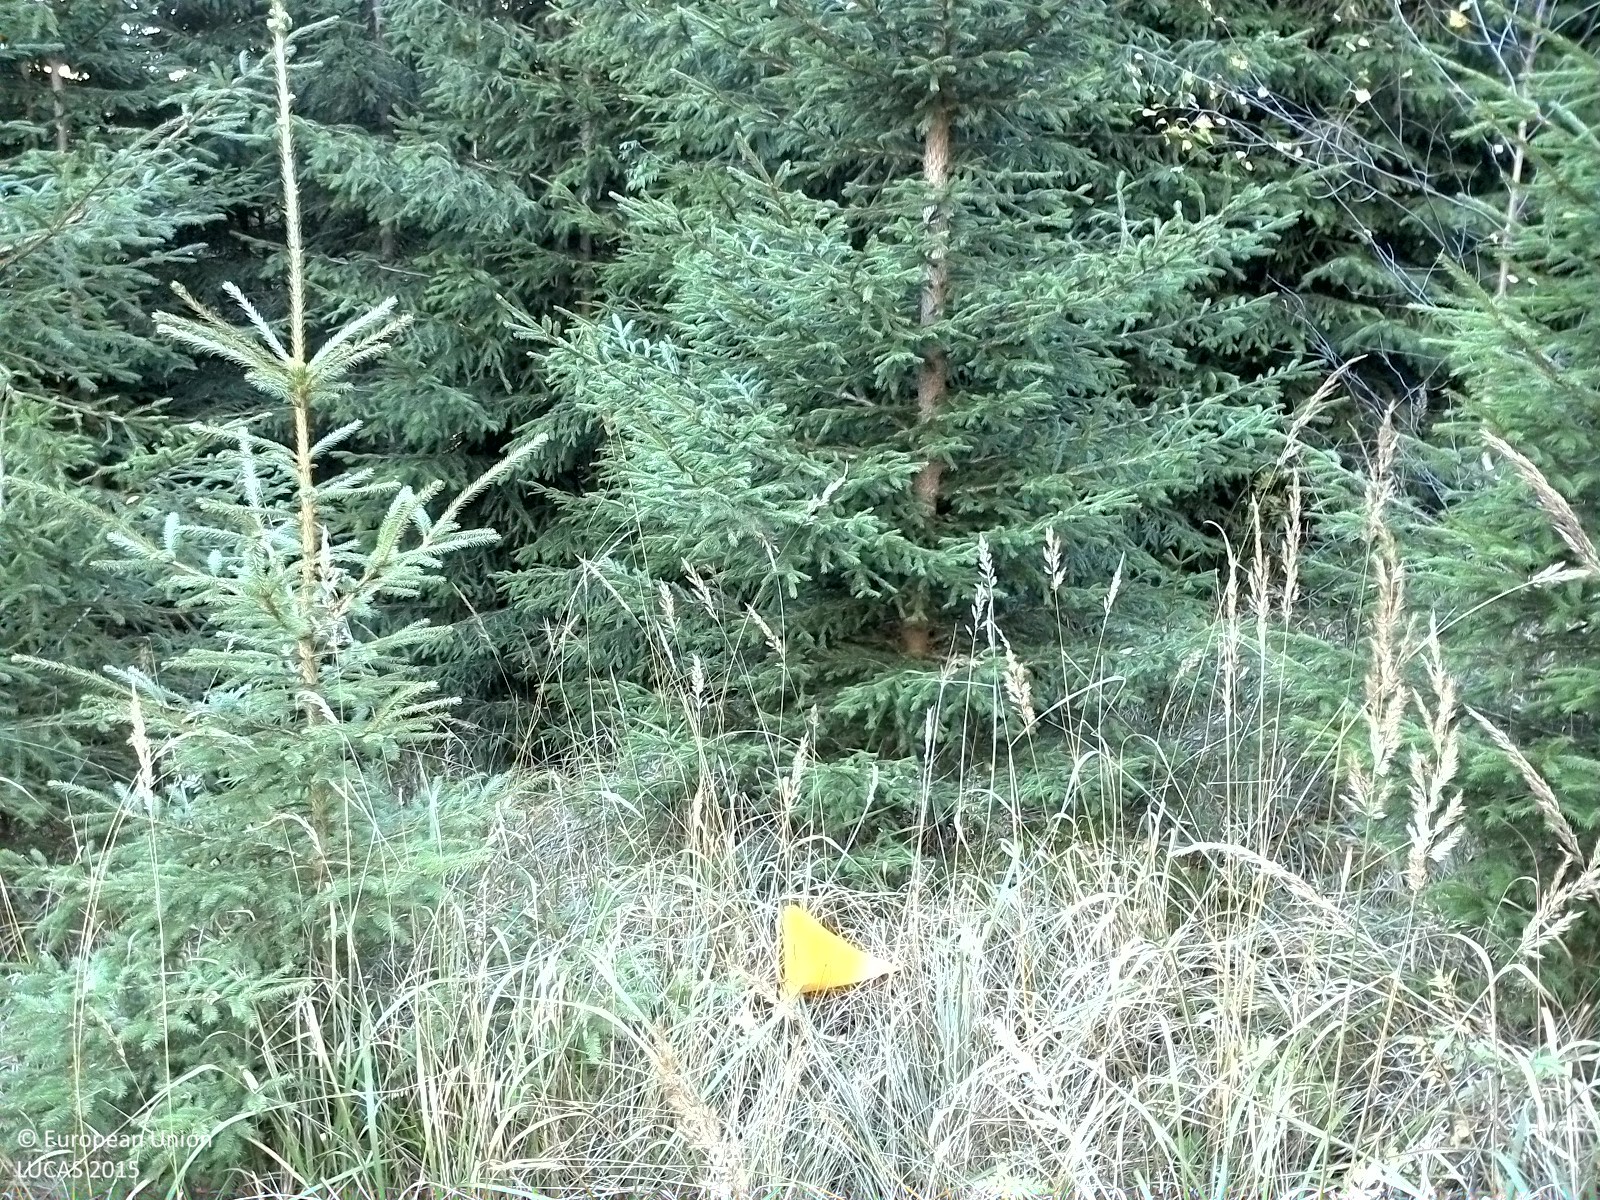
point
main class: Woodland
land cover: Spruce dominated coniferous woodland
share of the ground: 25 - 50 %
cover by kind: herbaceous plants 70 %, coniferous forest trees 25 %, broadleaved forest trees 5 %
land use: Forestry
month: September
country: SE
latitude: 62.6531
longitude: 16.9055
